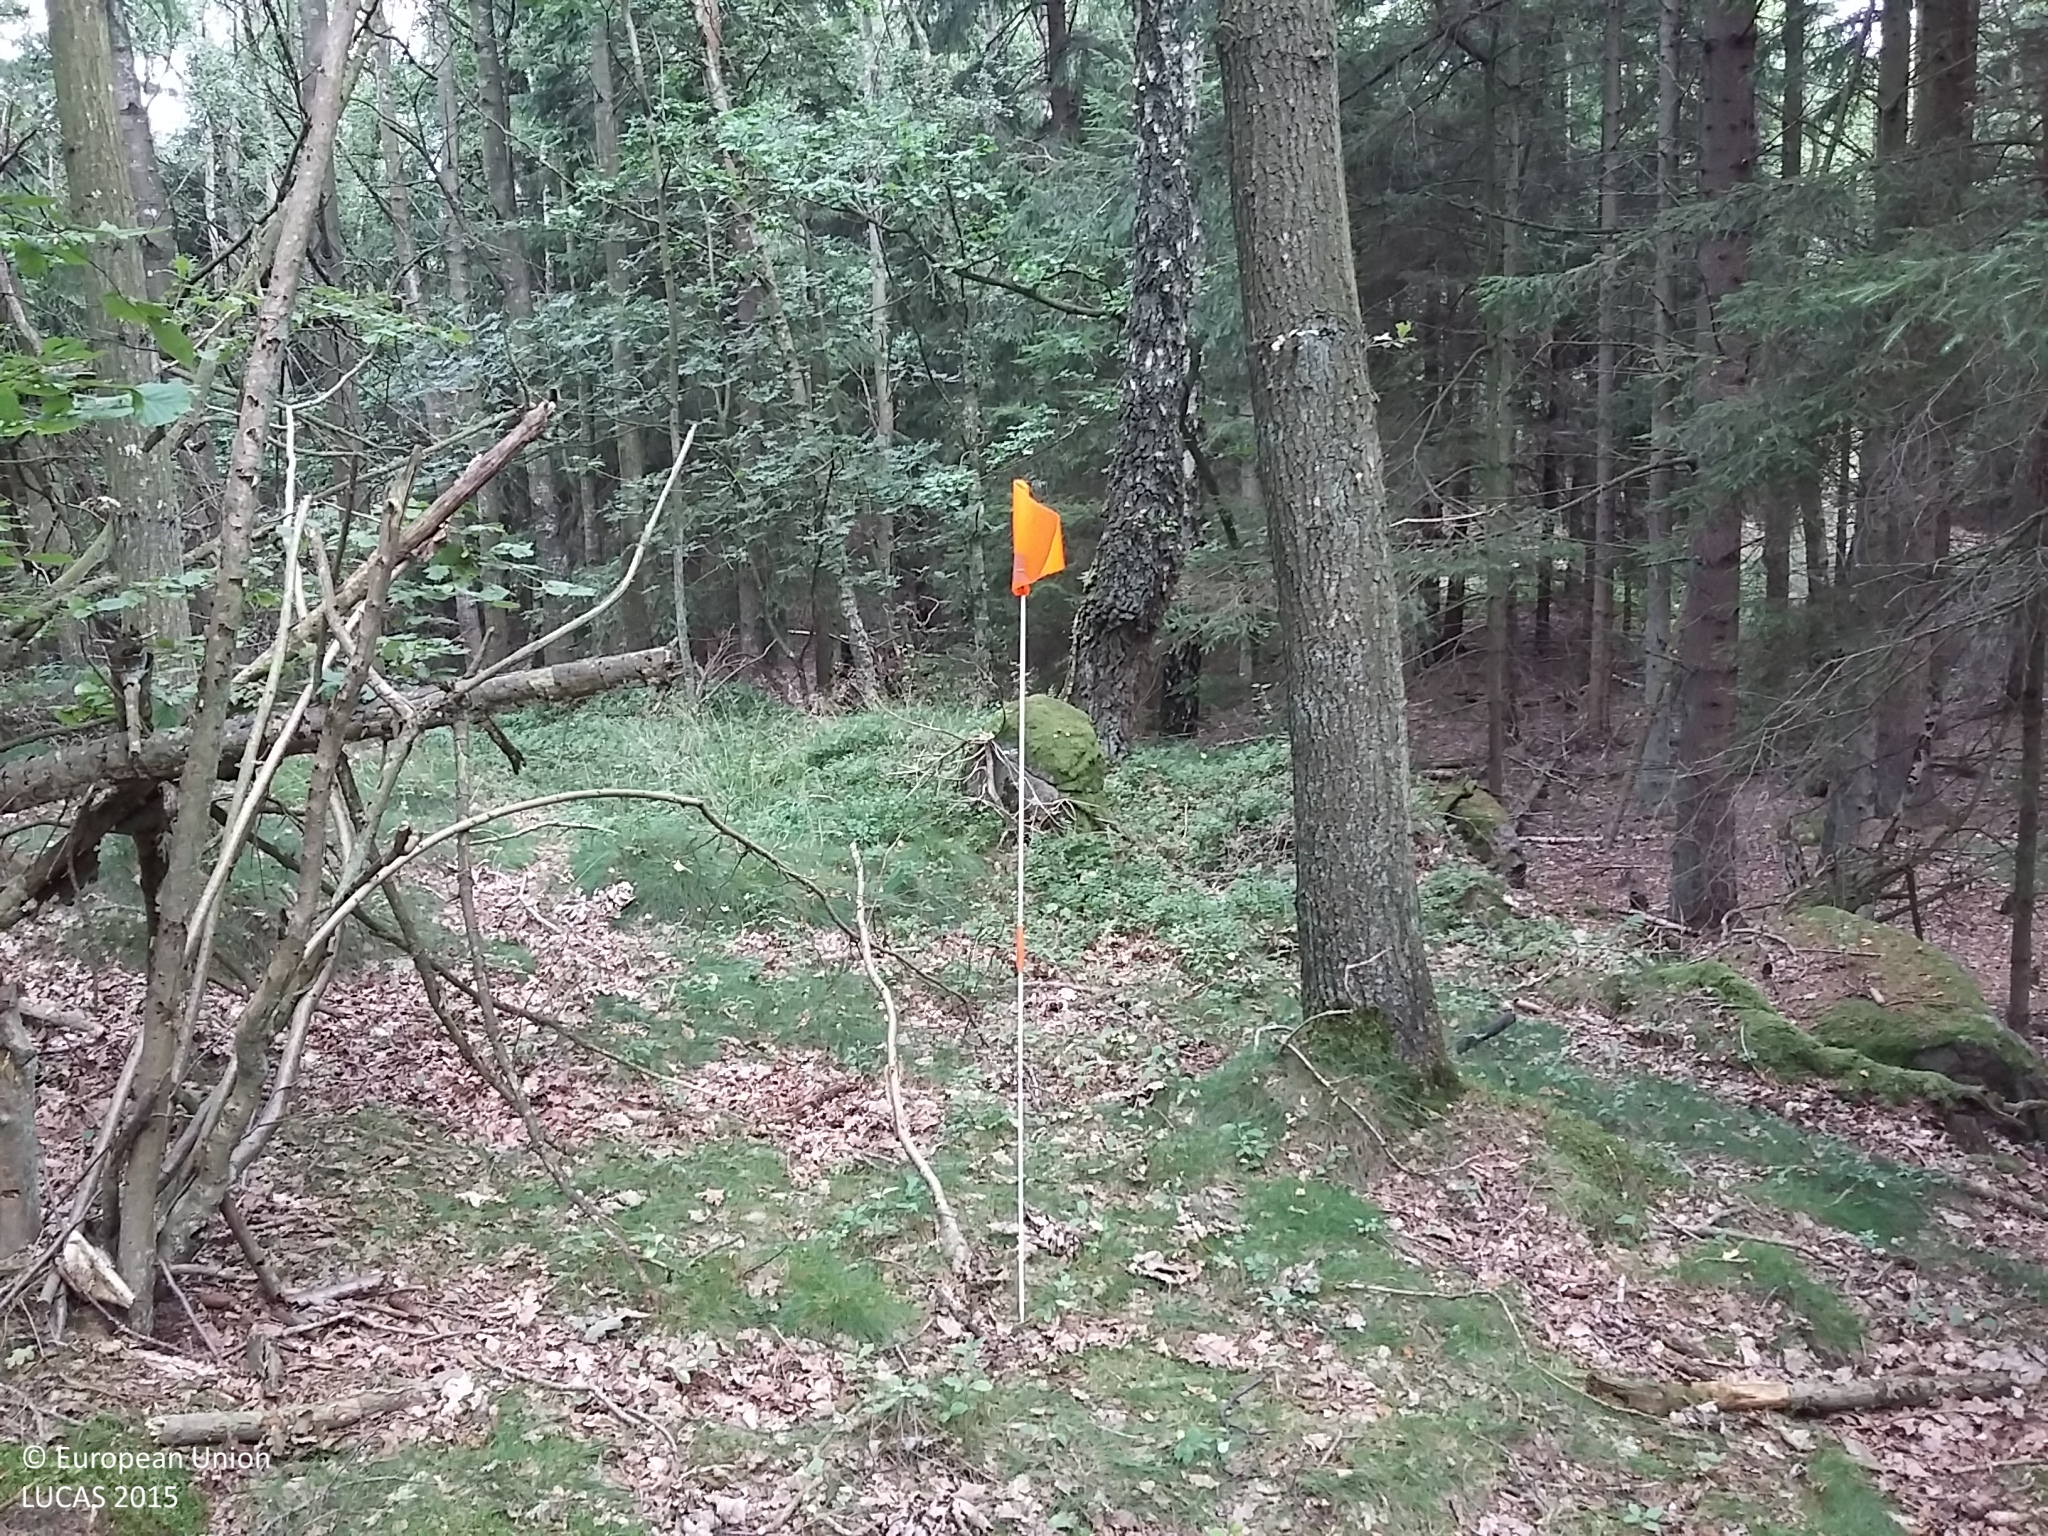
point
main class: Woodland
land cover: Other mixed woodland
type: hemiboreal forest and nemoral coniferous forest and mixed broadleaved-coniferous forest
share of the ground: > 75 %
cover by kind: coniferous forest trees 60 %, broadleaved forest trees 25 %, herbaceous plants 10 %, lichens and mosses 5 %
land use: Semi-natural and natural areas not in use
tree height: > 5 m
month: August
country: DK
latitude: 55.2529
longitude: 14.7667
